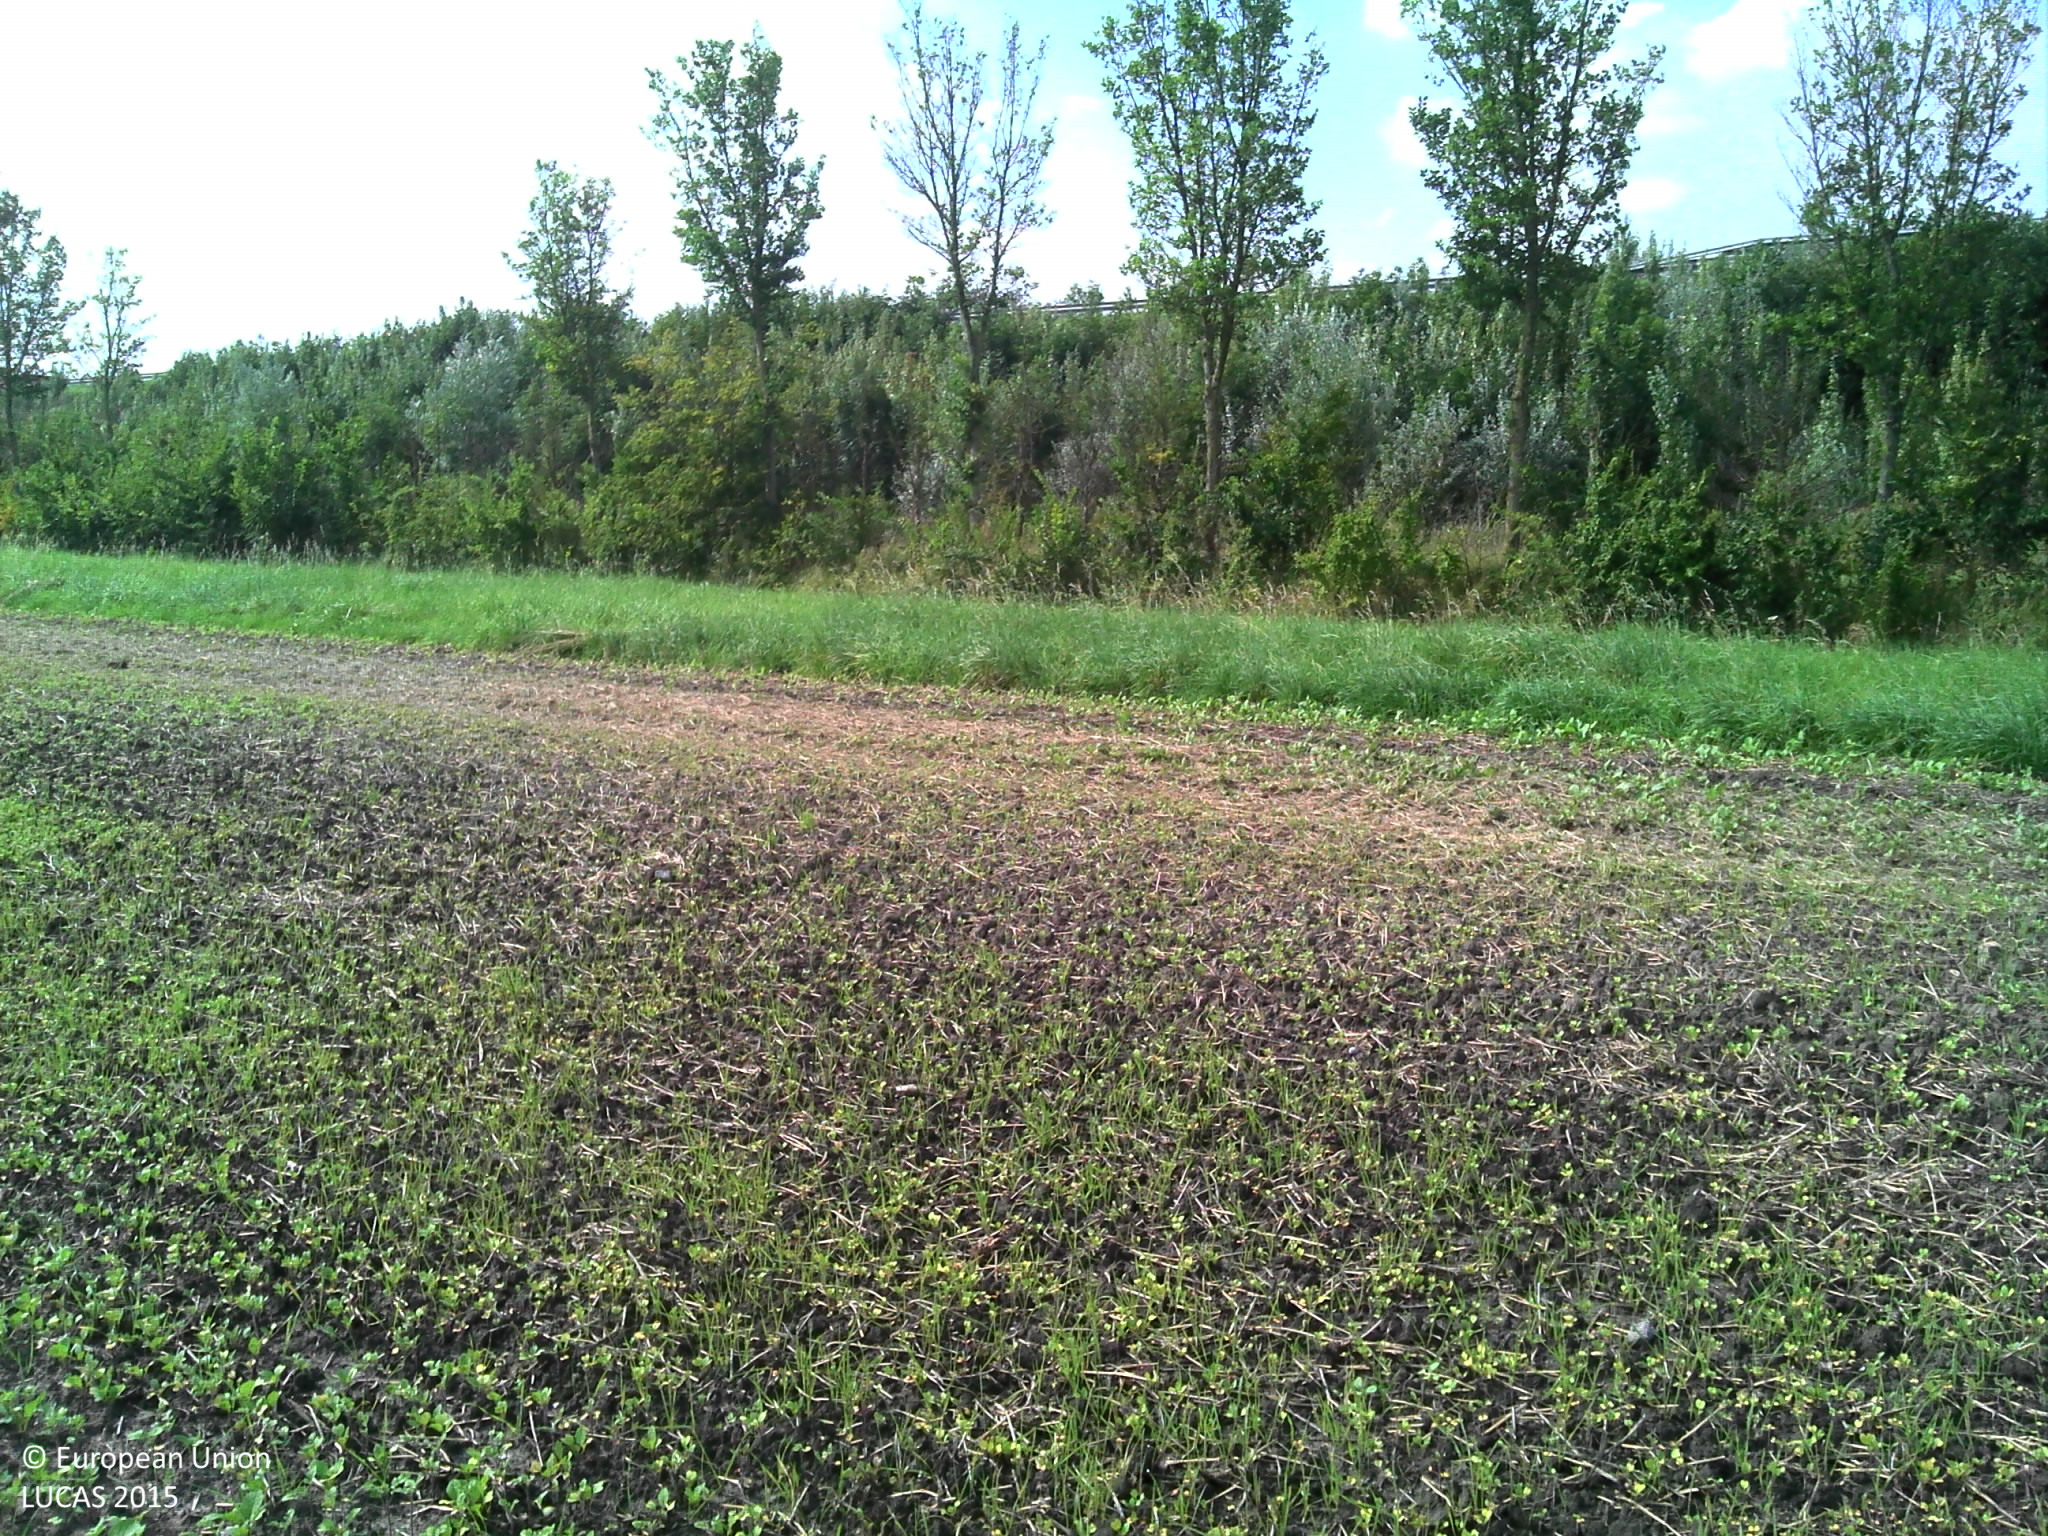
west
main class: Cropland
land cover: Common wheat
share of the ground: 25 - 50 %
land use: Agriculture (excluding fallow land and kitchen gardens)
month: September
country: BE
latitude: 51.0692
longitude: 2.6958
